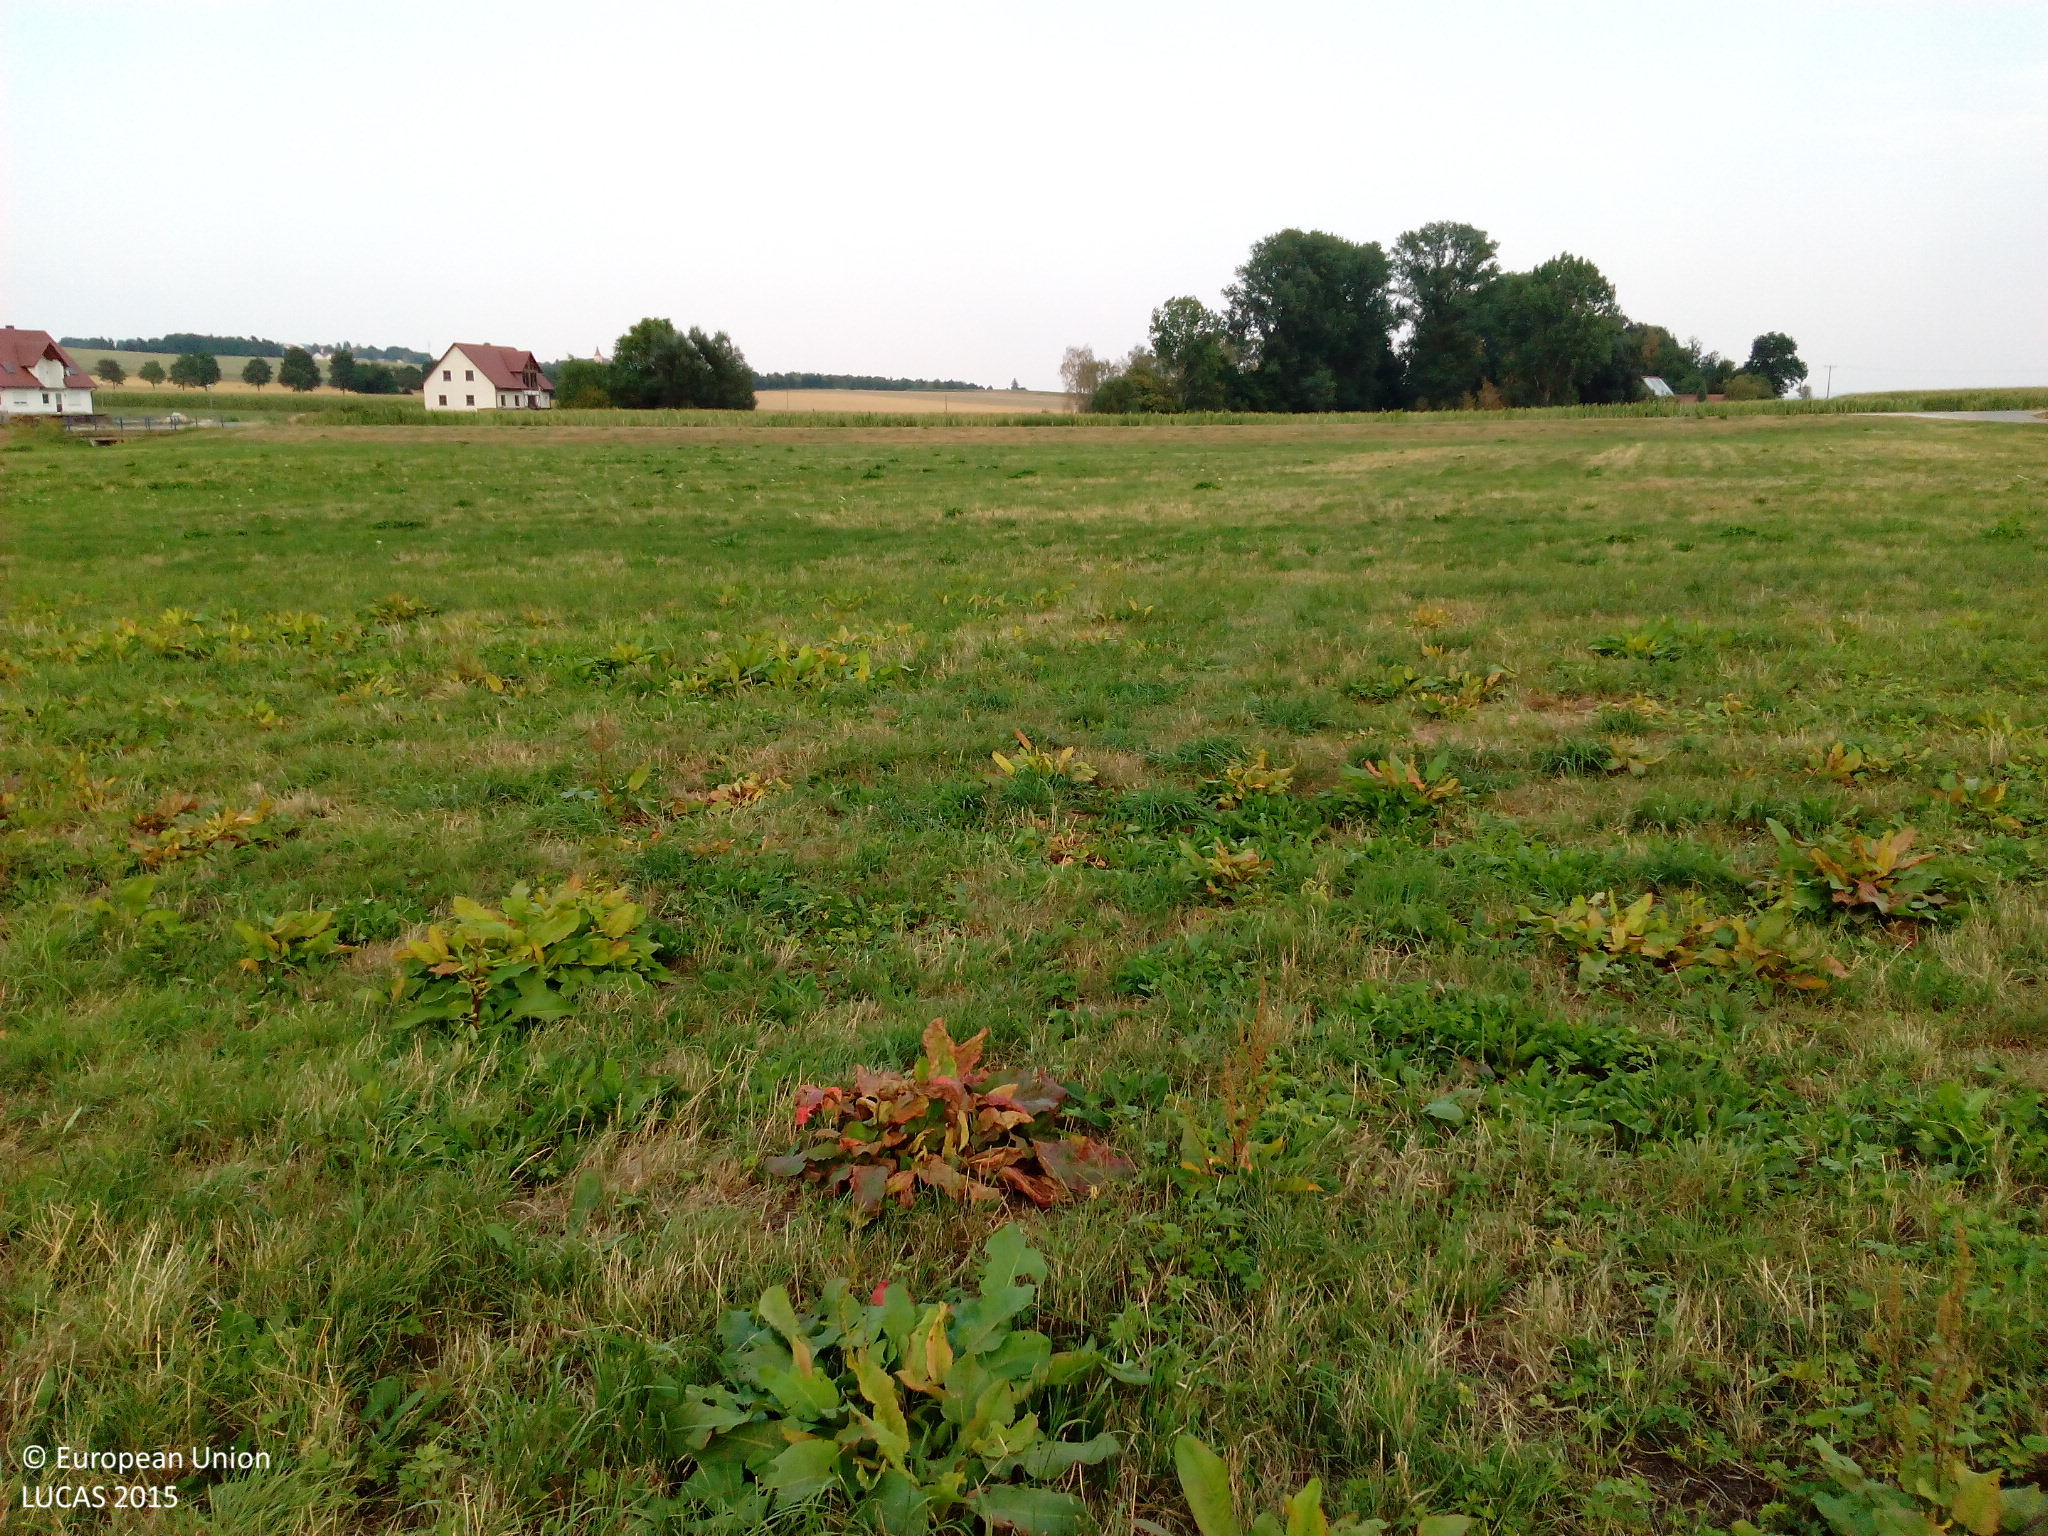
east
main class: Grassland
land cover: Grassland without tree/shrub cover
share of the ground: > 75 %
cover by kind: herbaceous plants 95 %, unconsolidated bare surface 5 %
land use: Agriculture (excluding fallow land and kitchen gardens)
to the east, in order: Grassland without tree/shrub cover; Paved roads, cycling and walking lanes; Grass margins; Maize
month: August
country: DE
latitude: 48.9599
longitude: 10.5324
